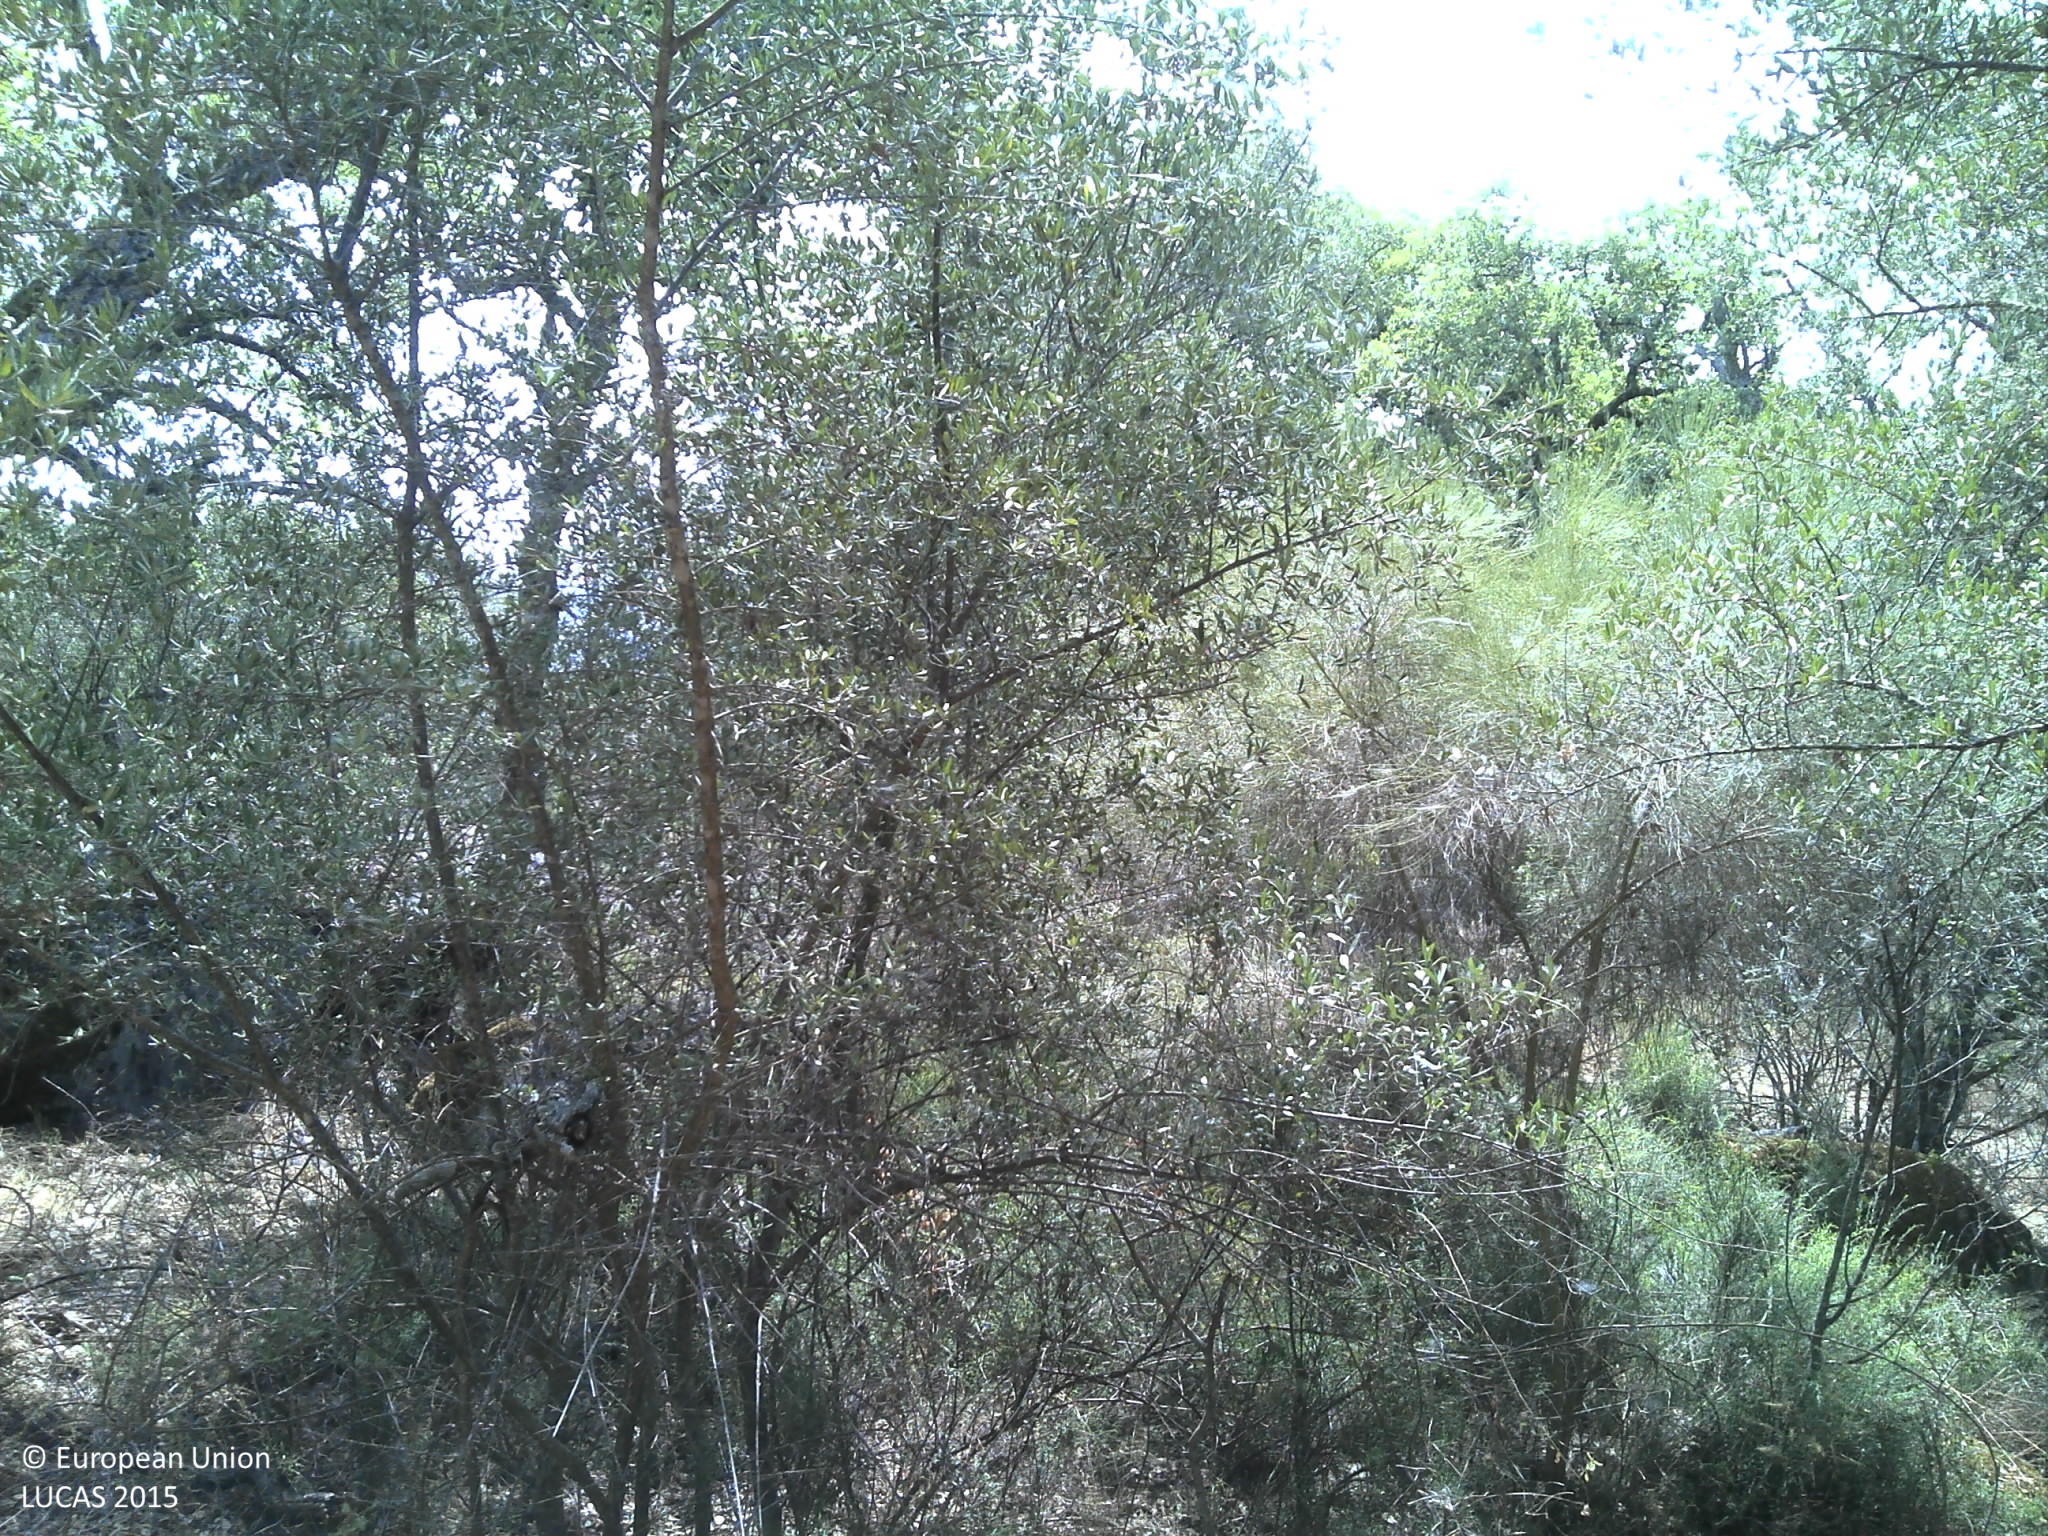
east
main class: Woodland
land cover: Broadleaved woodland
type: broadleaved evergreen forest
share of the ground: 25 - 50 %
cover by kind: broadleaved forest trees 50 %, consolidated bare surface 50 %
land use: Forestry
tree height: > 5 m
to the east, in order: Broadleaved woodland; Rocks and stones; Broadleaved woodland; Tracks; Shrubland without tree cover; Broadleaved woodland; Tracks; Shrubland without tree cover; Tracks; Shruby margins; Fences; Shruby margins; Grassland without tree/shrub cover
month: August
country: PT
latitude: 39.2778
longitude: -7.4650
